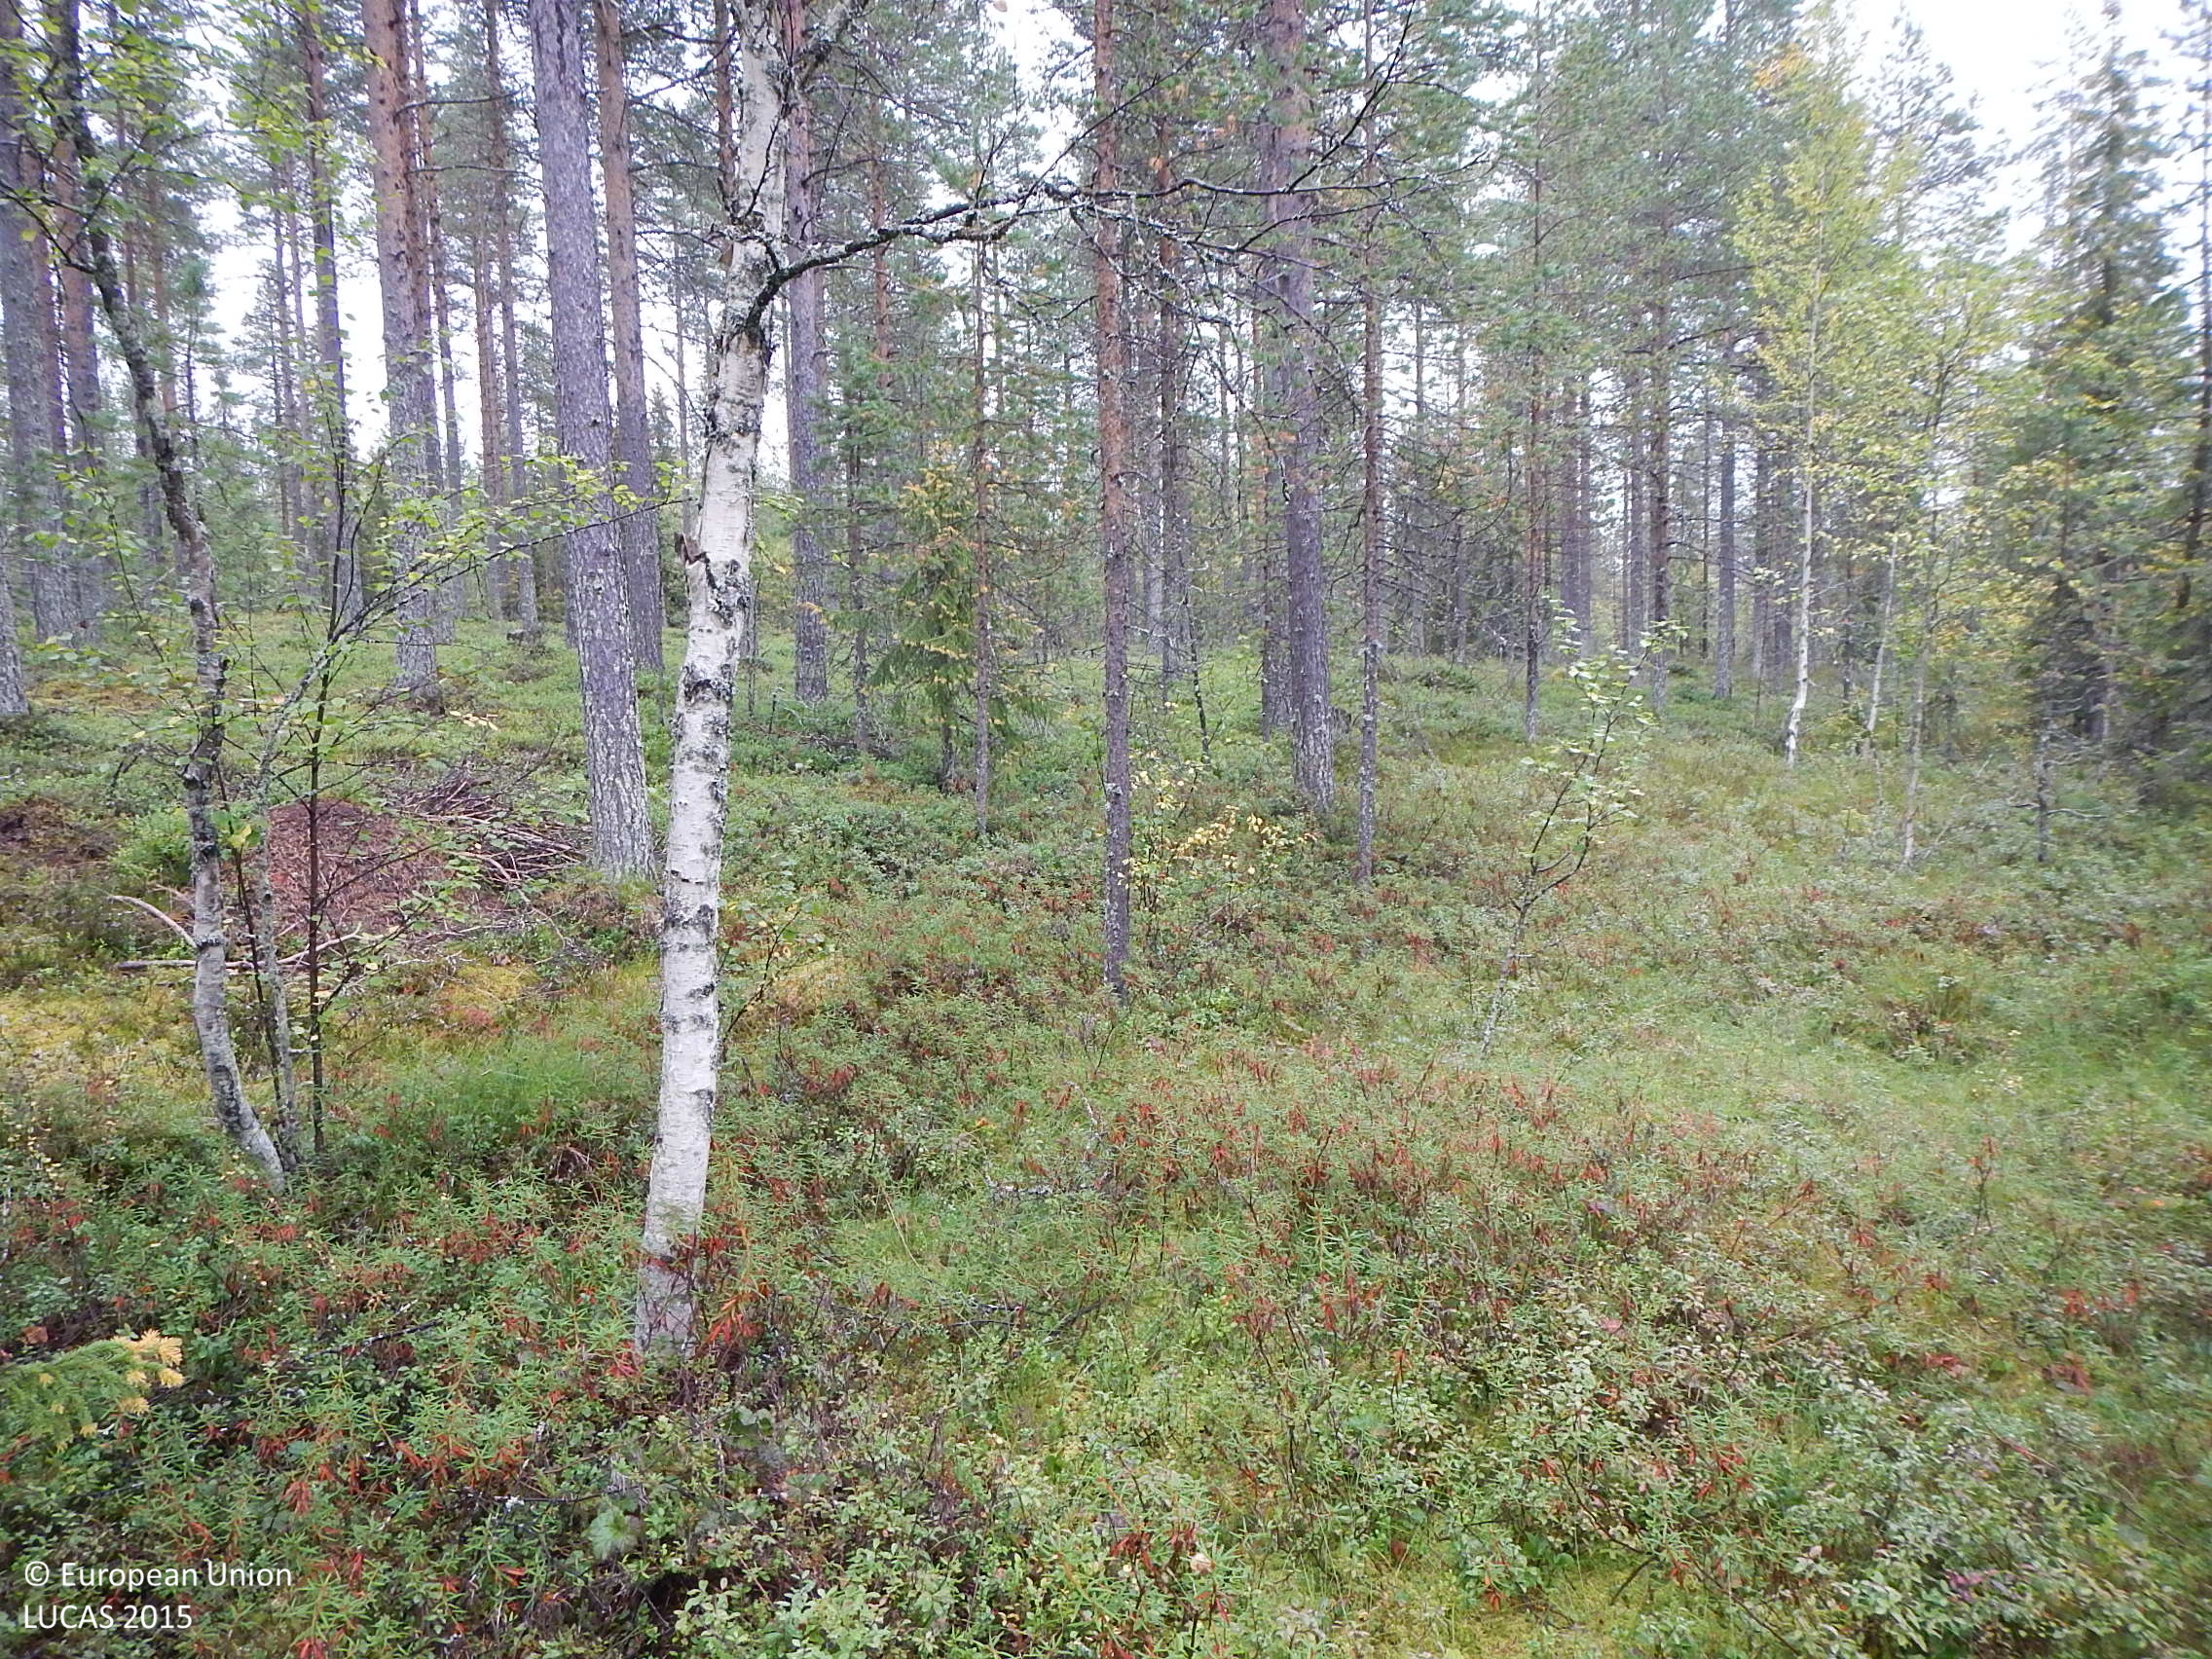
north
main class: Woodland
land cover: Pine dominated coniferous woodland
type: boreal forest
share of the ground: 50 - 75 %
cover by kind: coniferous forest trees 60 %, shrubs 20 %, broadleaved forest trees 10 %, herbaceous plants 10 %
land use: Forestry
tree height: > 5 m
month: August
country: FI
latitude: 65.9762
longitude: 27.3994
